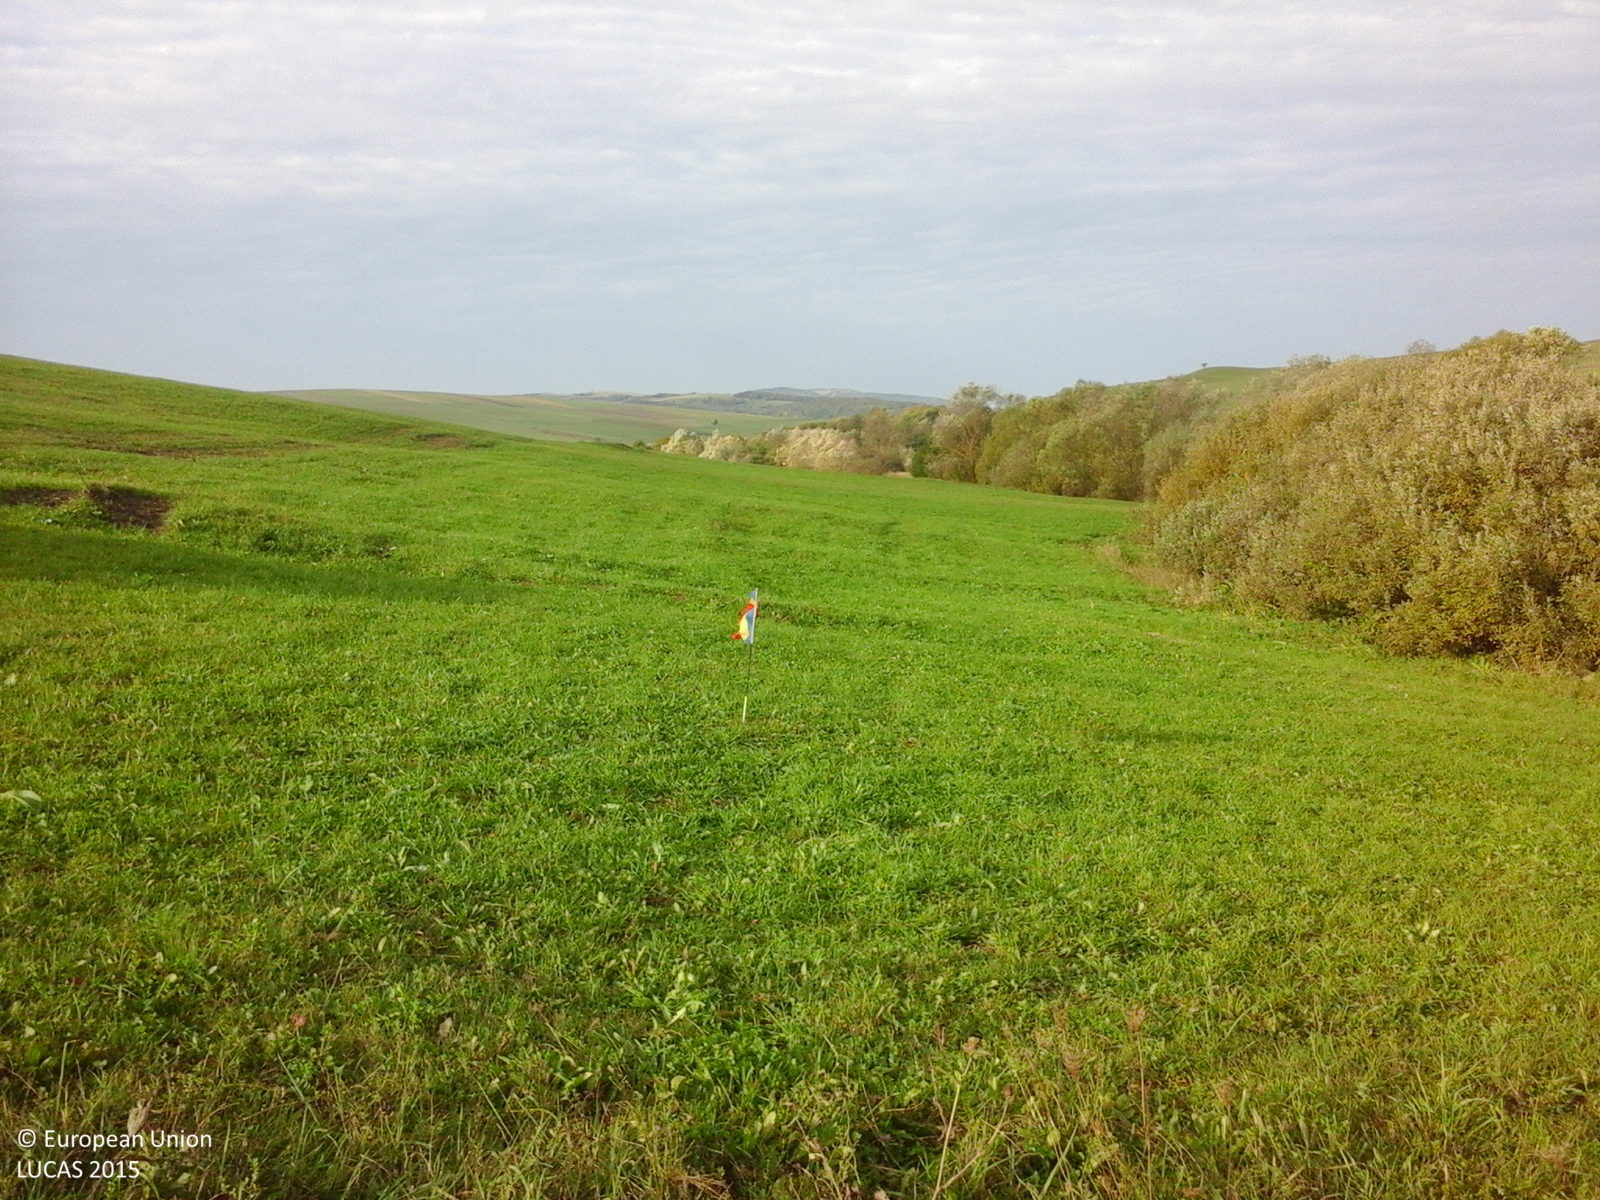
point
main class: Grassland
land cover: Grassland without tree/shrub cover
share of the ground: > 75 %
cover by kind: herbaceous plants 100 %
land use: Agriculture (excluding fallow land and kitchen gardens)
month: October
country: RO
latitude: 46.3602
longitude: 25.2966
